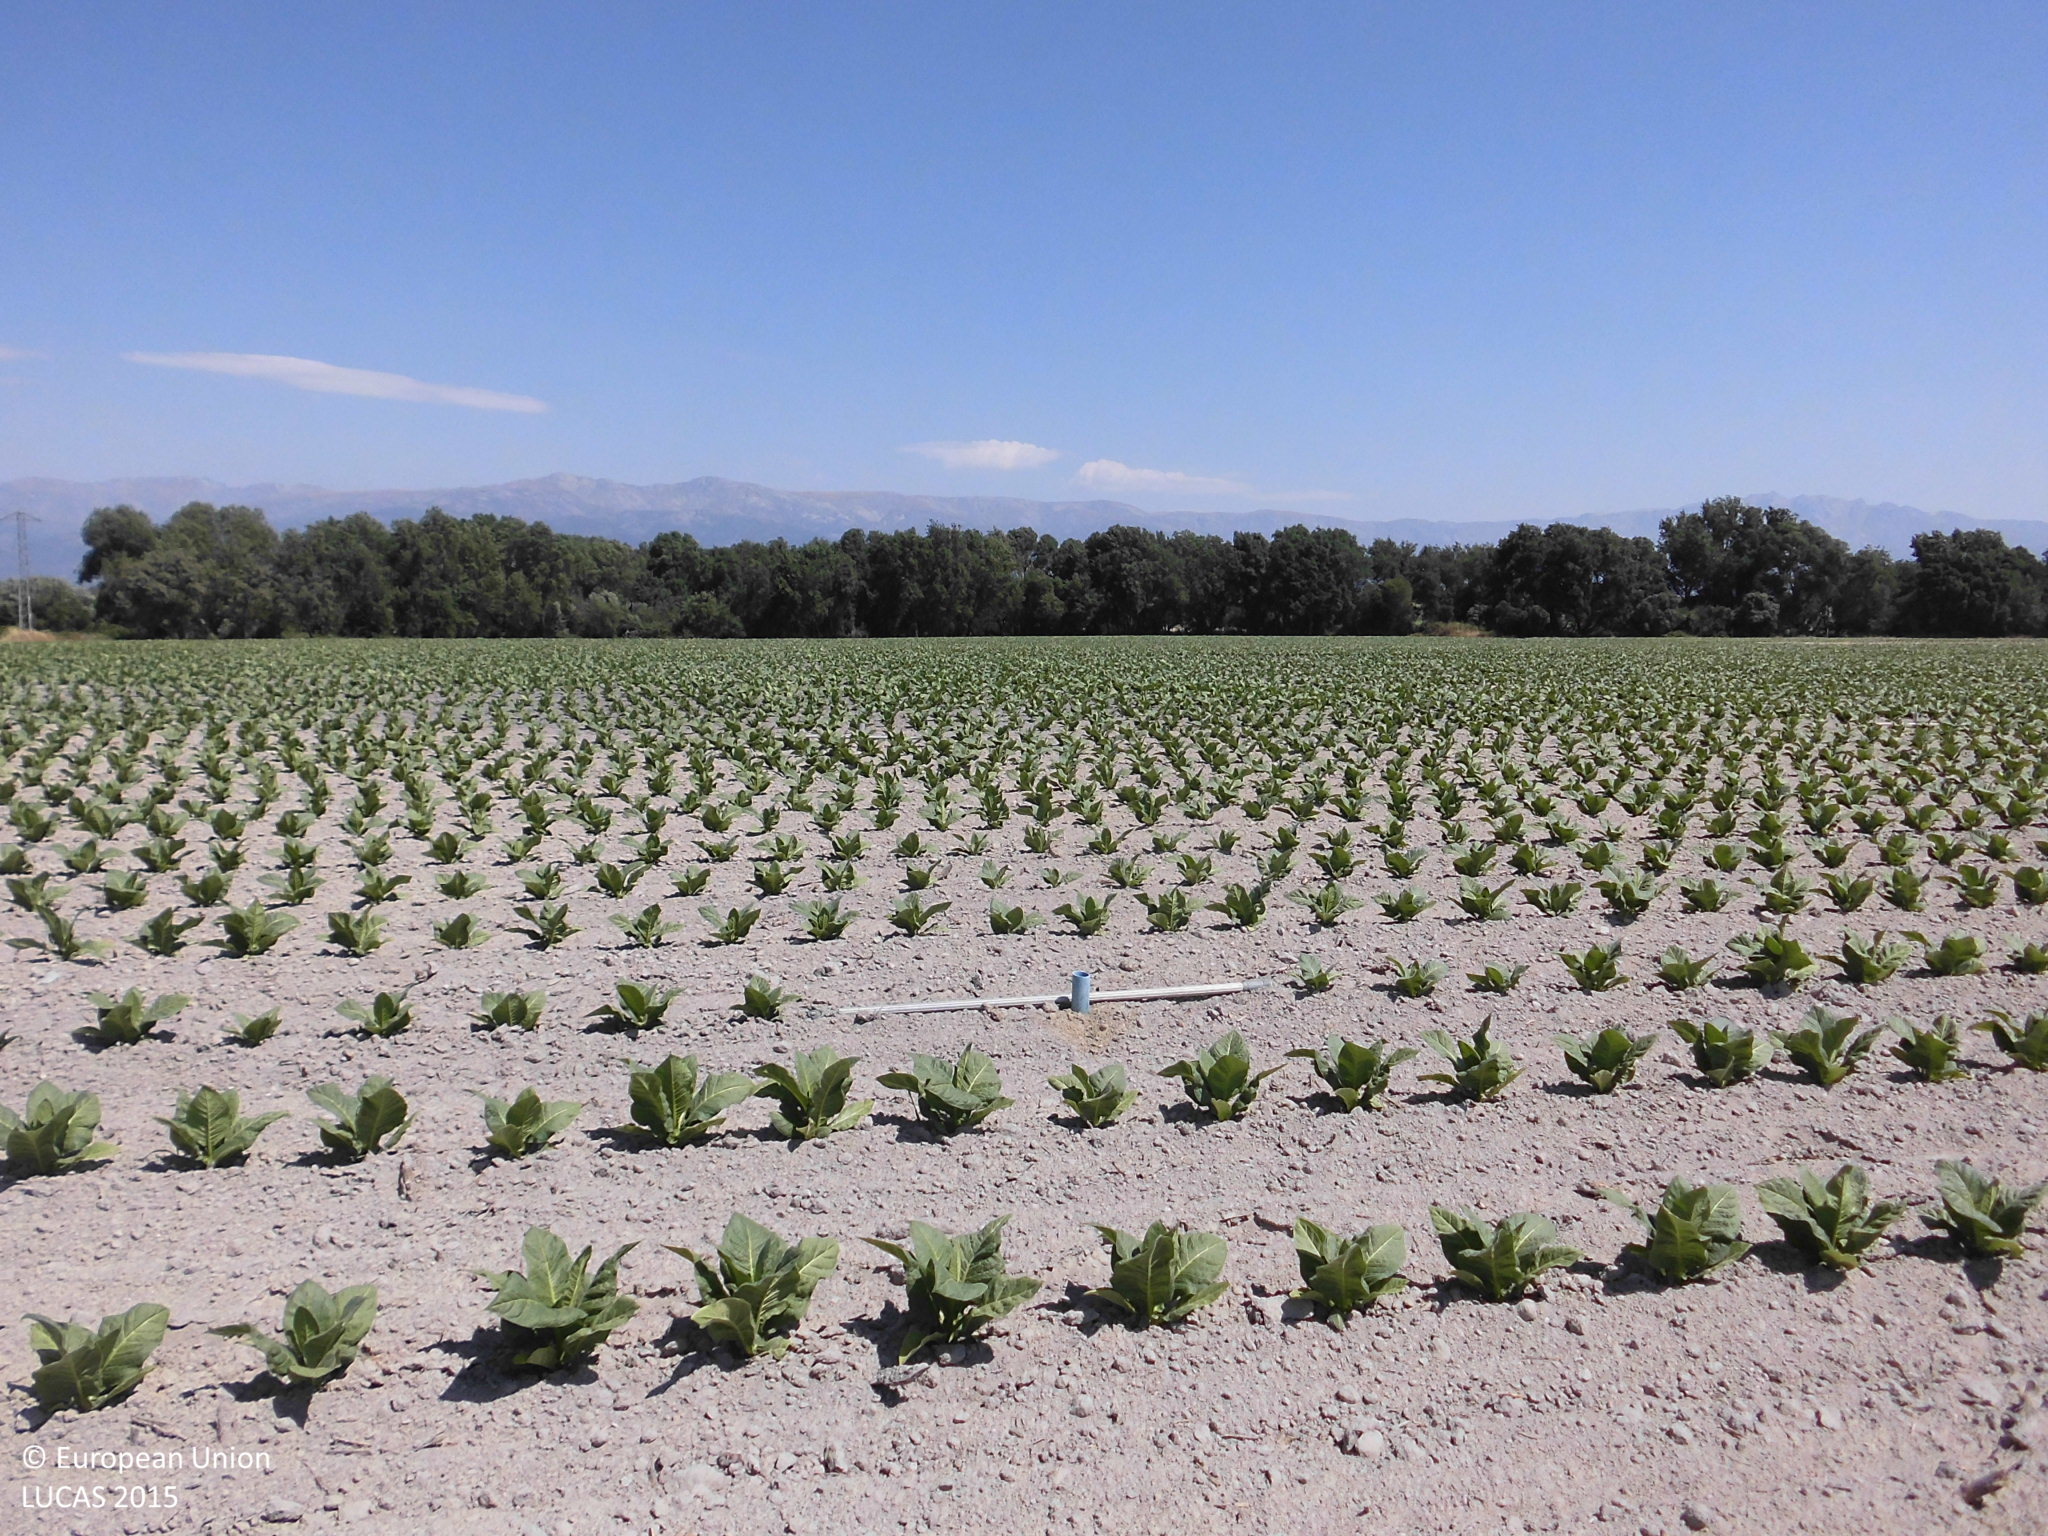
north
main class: Cropland
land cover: Tobacco
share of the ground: 10 - 25 %
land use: Agriculture (excluding fallow land and kitchen gardens)
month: June
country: ES
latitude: 39.9931
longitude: -5.4365
